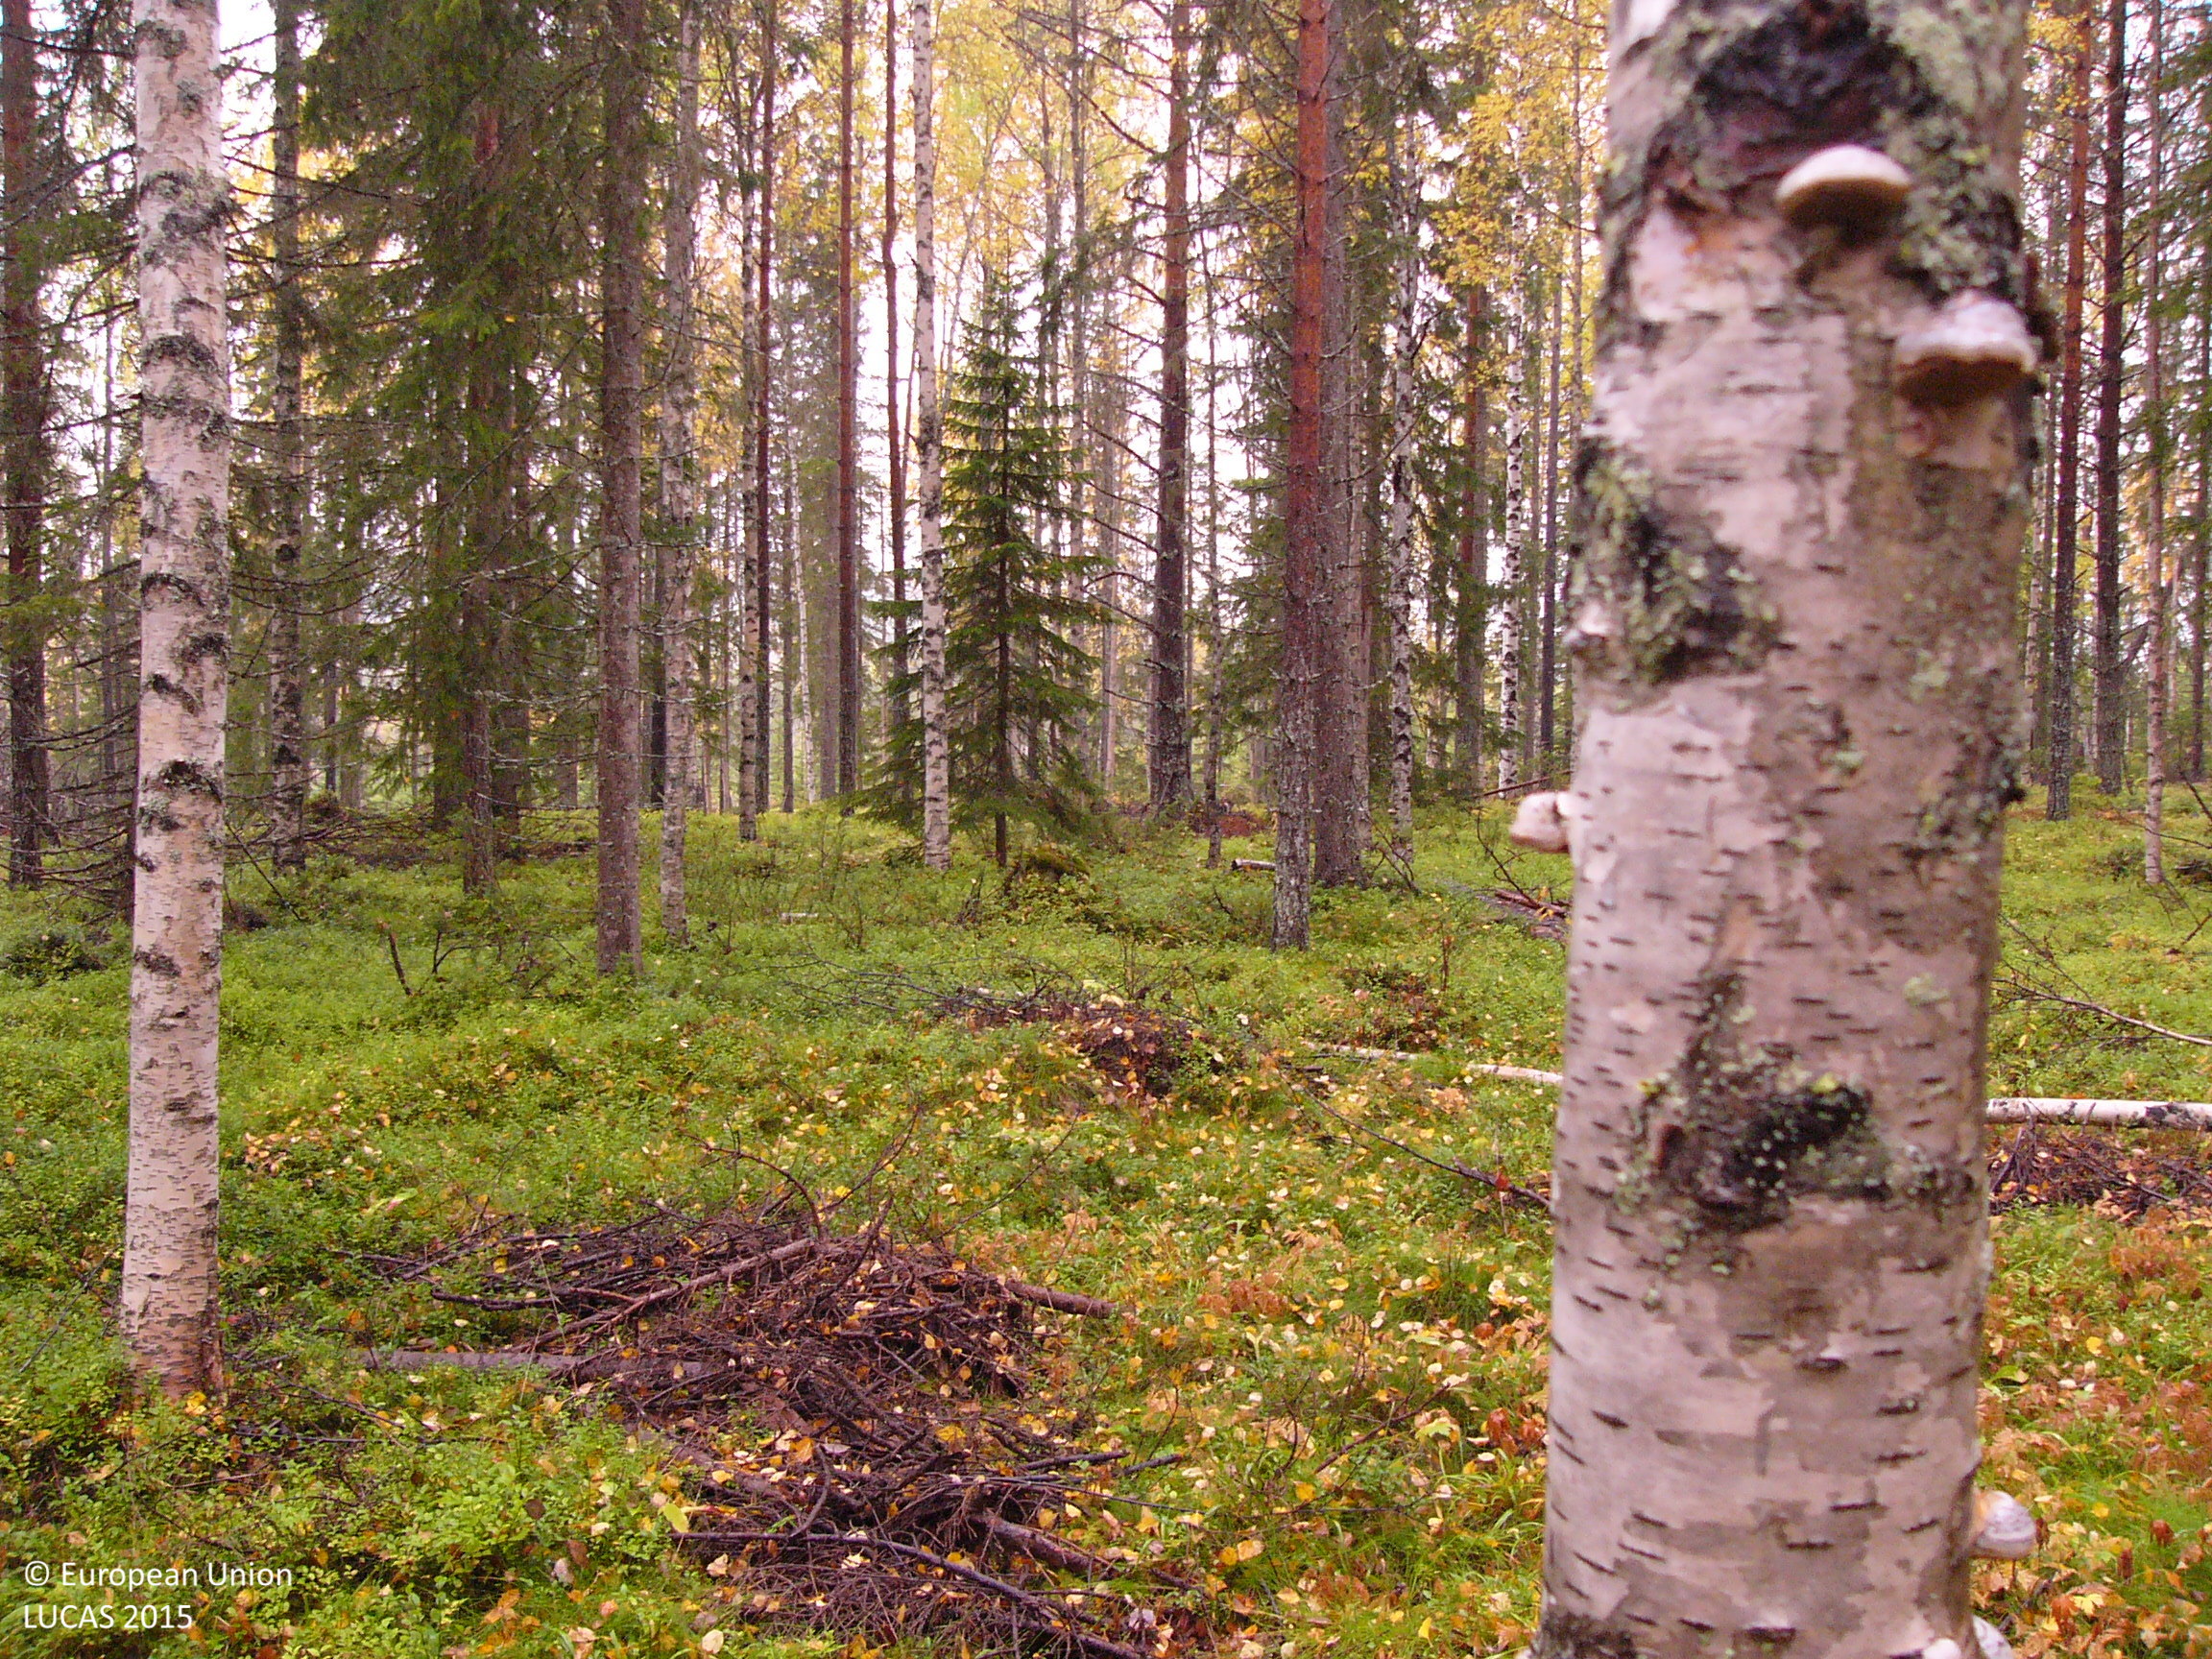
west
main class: Woodland
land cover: Spruce dominated mixed woodland
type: boreal forest
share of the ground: 50 - 75 %
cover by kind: coniferous forest trees 45 %, shrubs 20 %, broadleaved forest trees 15 %, lichens and mosses 15 %, herbaceous plants 5 %
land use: Forestry
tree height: > 5 m
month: September
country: SE
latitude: 64.7867
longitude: 18.8664
